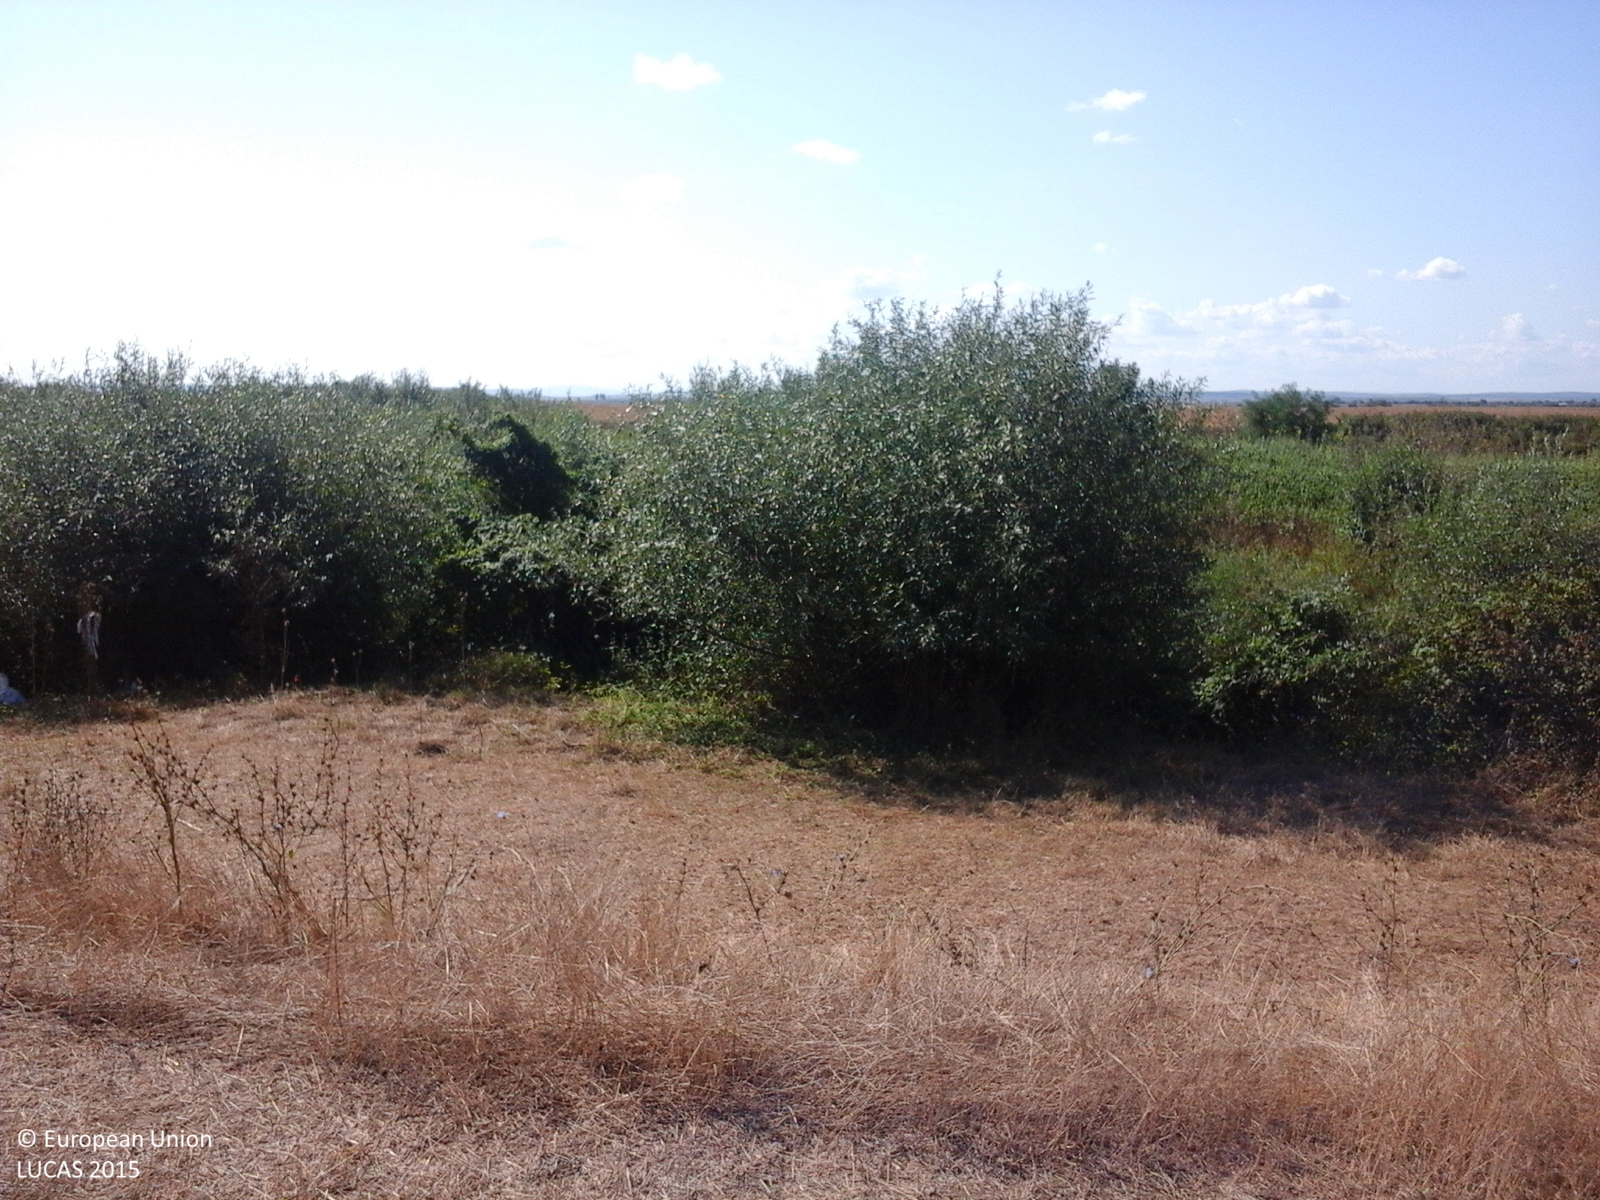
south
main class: Grassland
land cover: Grassland without tree/shrub cover
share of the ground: > 75 %
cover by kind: herbaceous plants 100 %
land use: Agriculture (excluding fallow land and kitchen gardens)
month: September
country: RO
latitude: 47.5876
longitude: 22.7605
